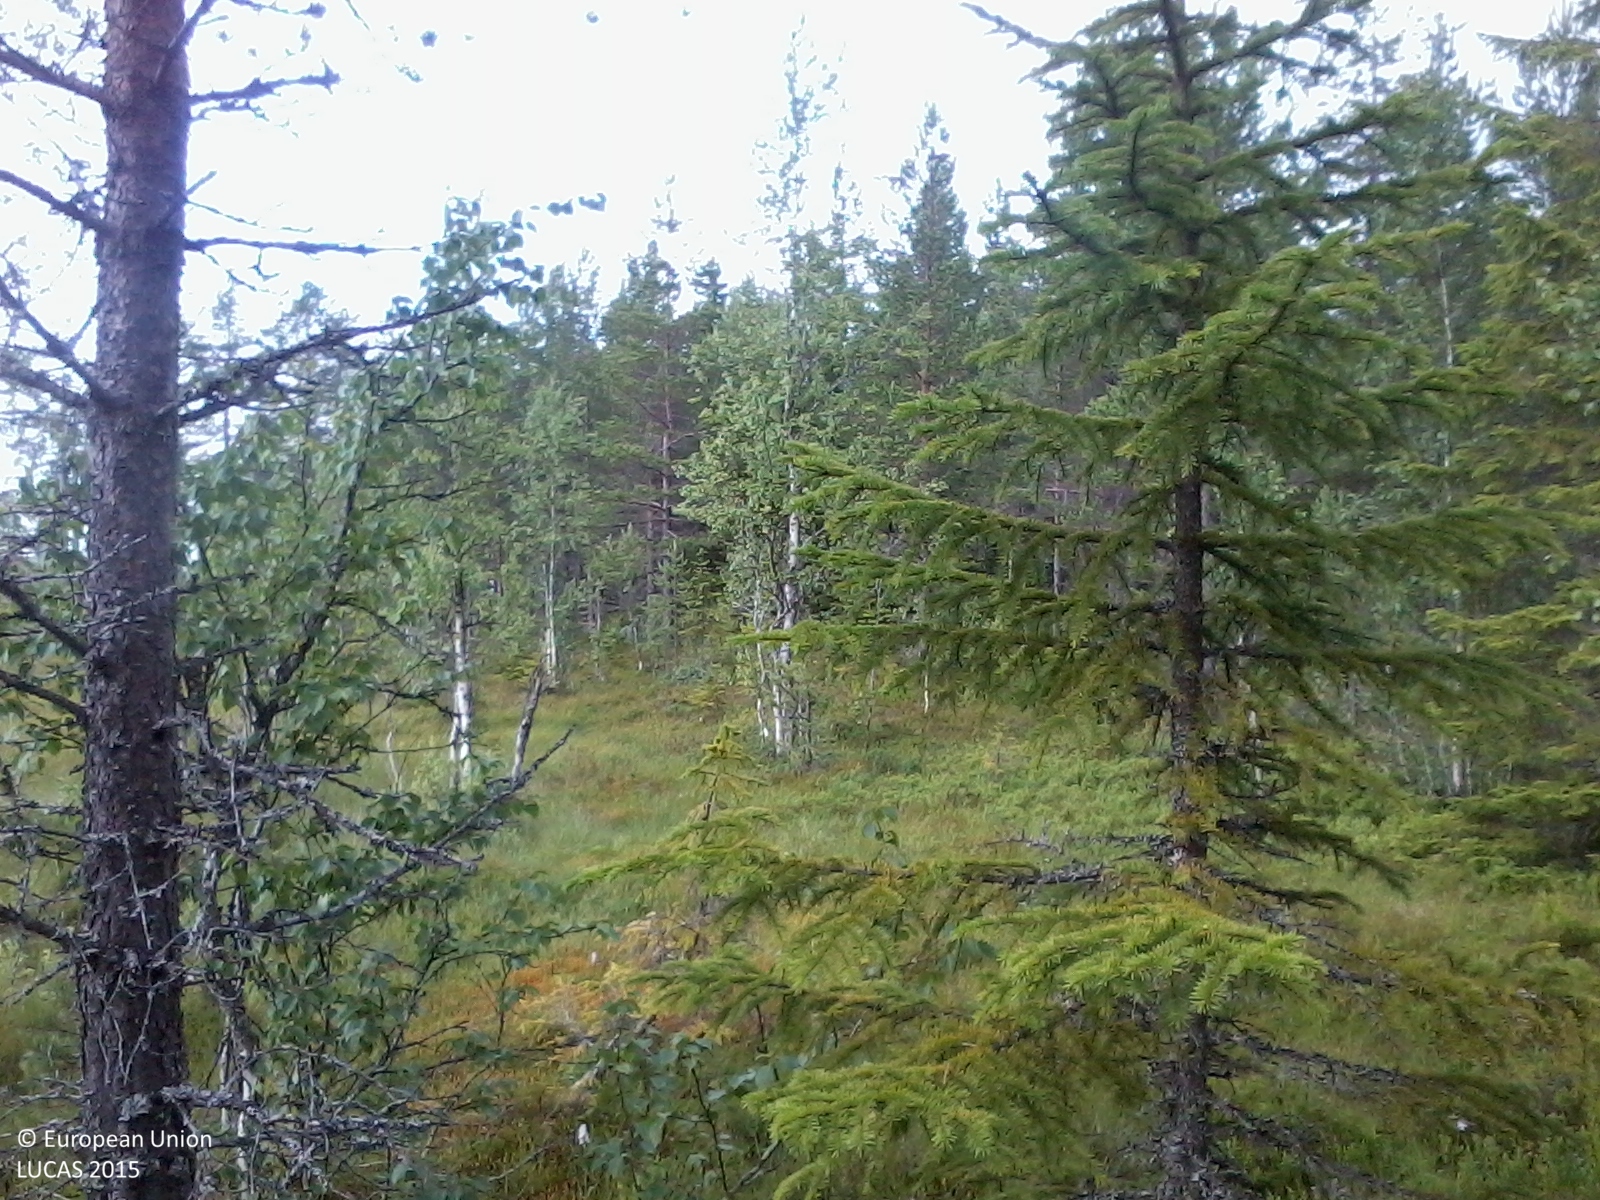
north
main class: Woodland
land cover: Pine dominated mixed woodland
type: boreal forest
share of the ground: 25 - 50 %
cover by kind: shrubs 50 %, coniferous forest trees 20 %, lichens and mosses 20 %, broadleaved forest trees 10 %
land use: Semi-natural and natural areas not in use
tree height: > 5 m
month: July
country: SE
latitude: 62.7535
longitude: 17.0852
